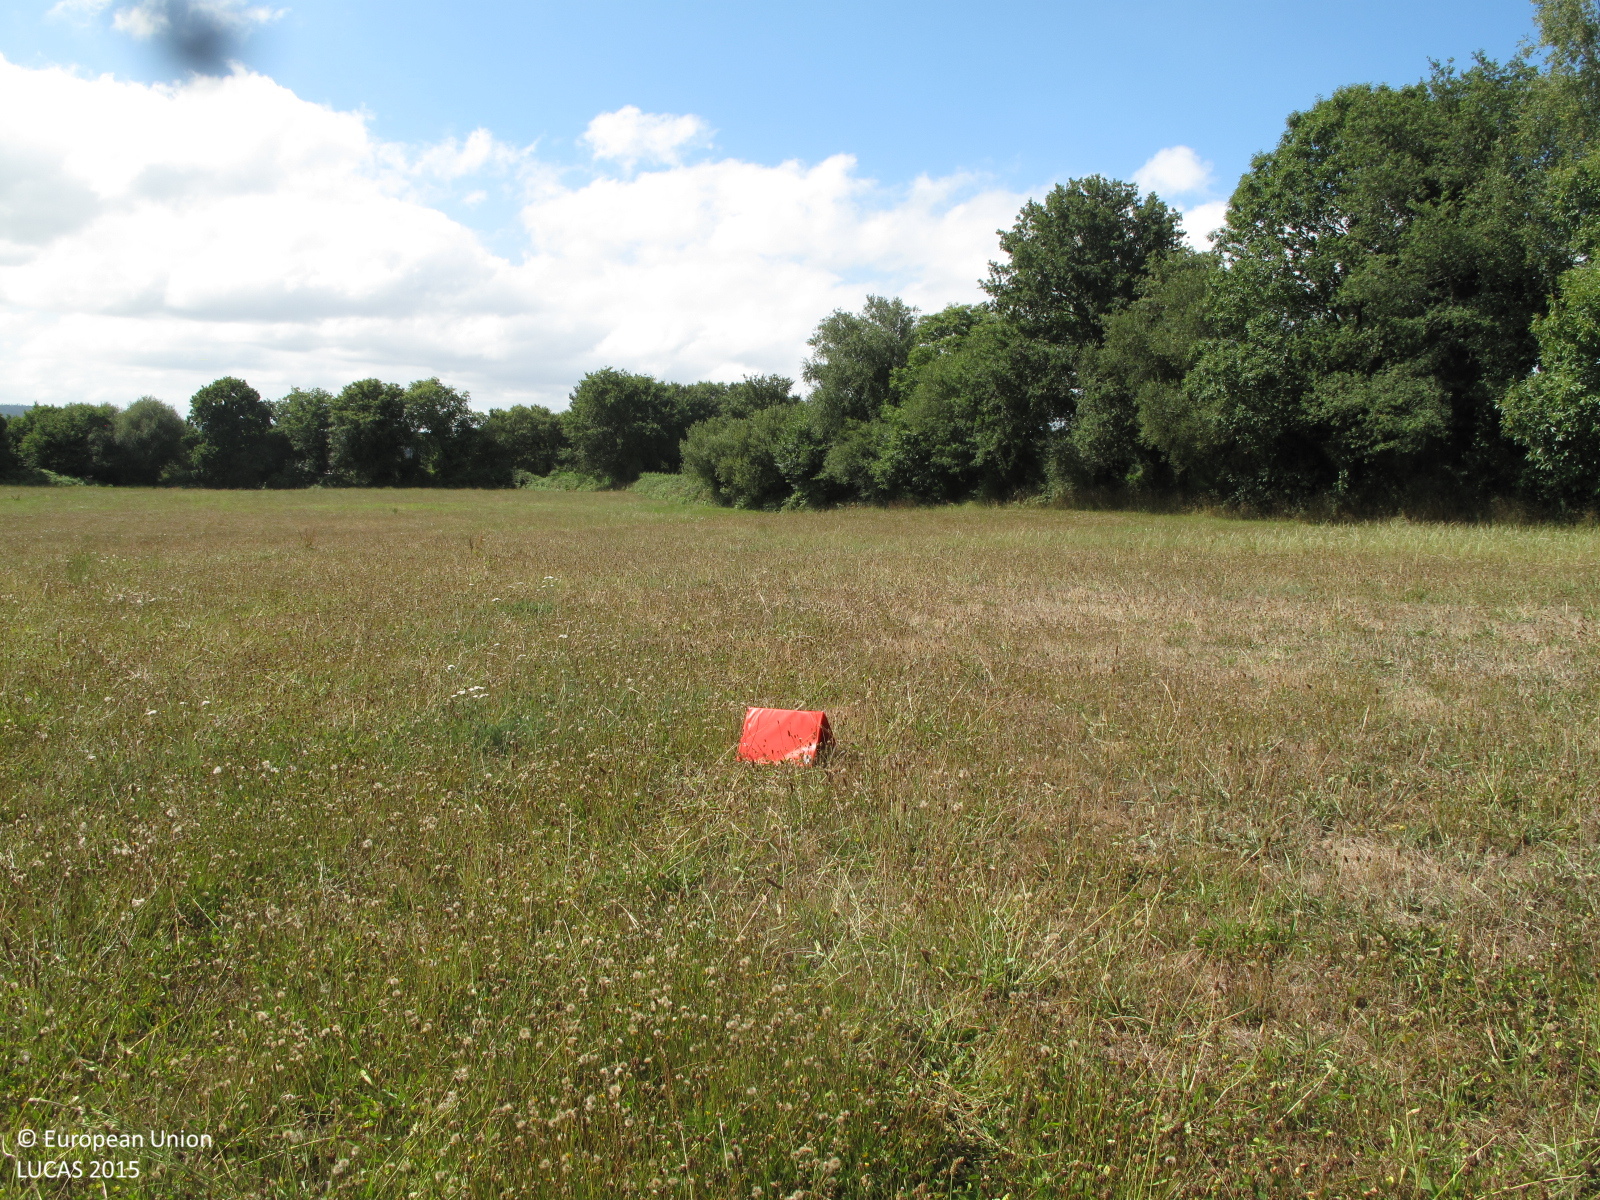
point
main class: Grassland
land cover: Grassland without tree/shrub cover
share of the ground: > 75 %
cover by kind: herbaceous plants 100 %
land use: Agriculture (excluding fallow land and kitchen gardens)
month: July
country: ES
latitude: 43.0987
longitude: -8.0681
